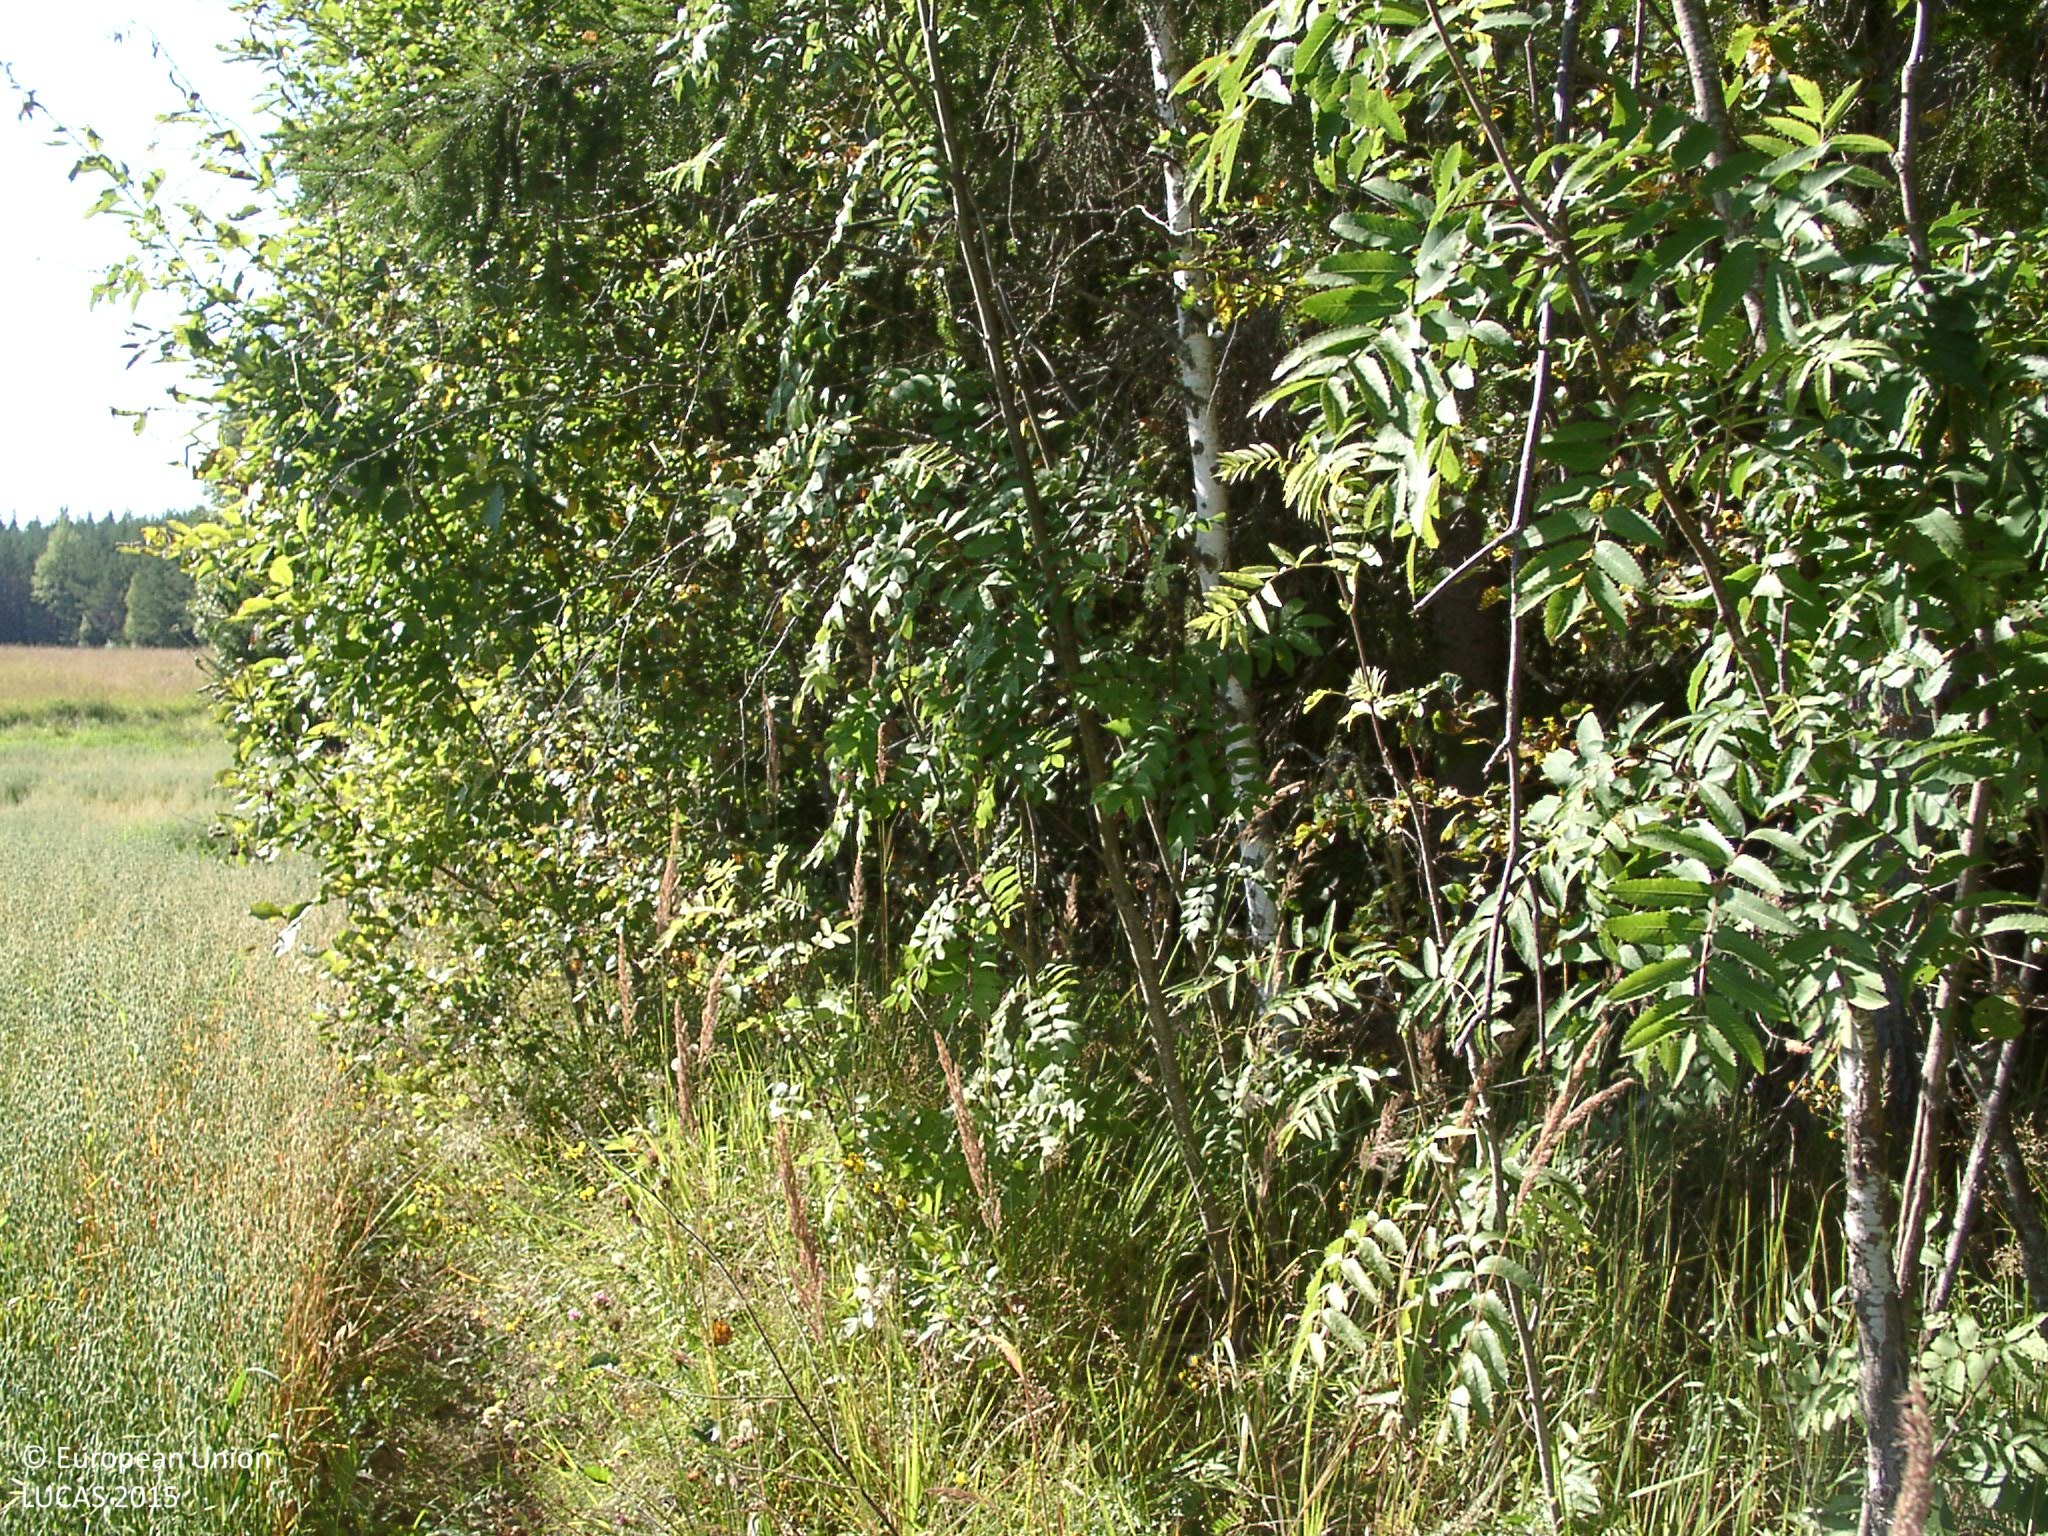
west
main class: Cropland
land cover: Oats
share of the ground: > 75 %
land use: Agriculture (excluding fallow land and kitchen gardens)
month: August
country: FI
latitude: 61.9902
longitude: 24.9347
